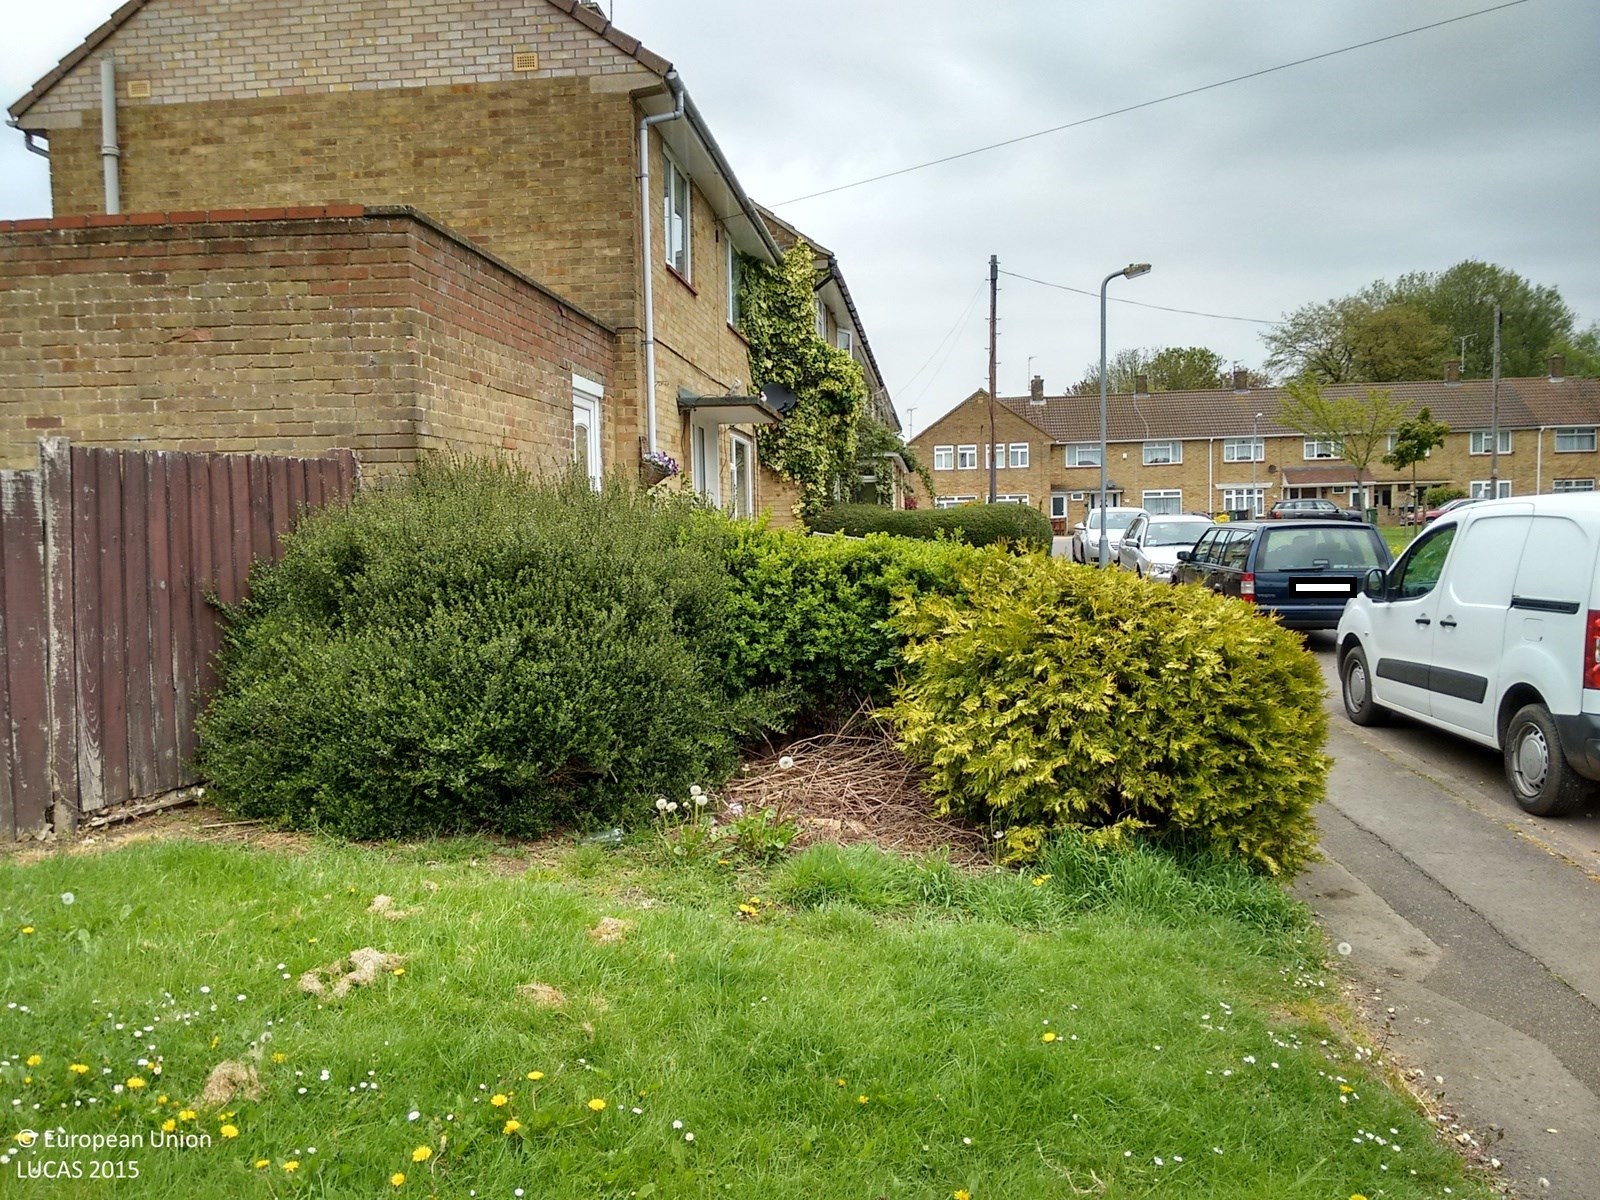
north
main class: Grassland
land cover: Grassland without tree/shrub cover
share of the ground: > 75 %
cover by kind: herbaceous plants 100 %
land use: Residential
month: May
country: GB
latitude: 51.7515
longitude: -0.4529
